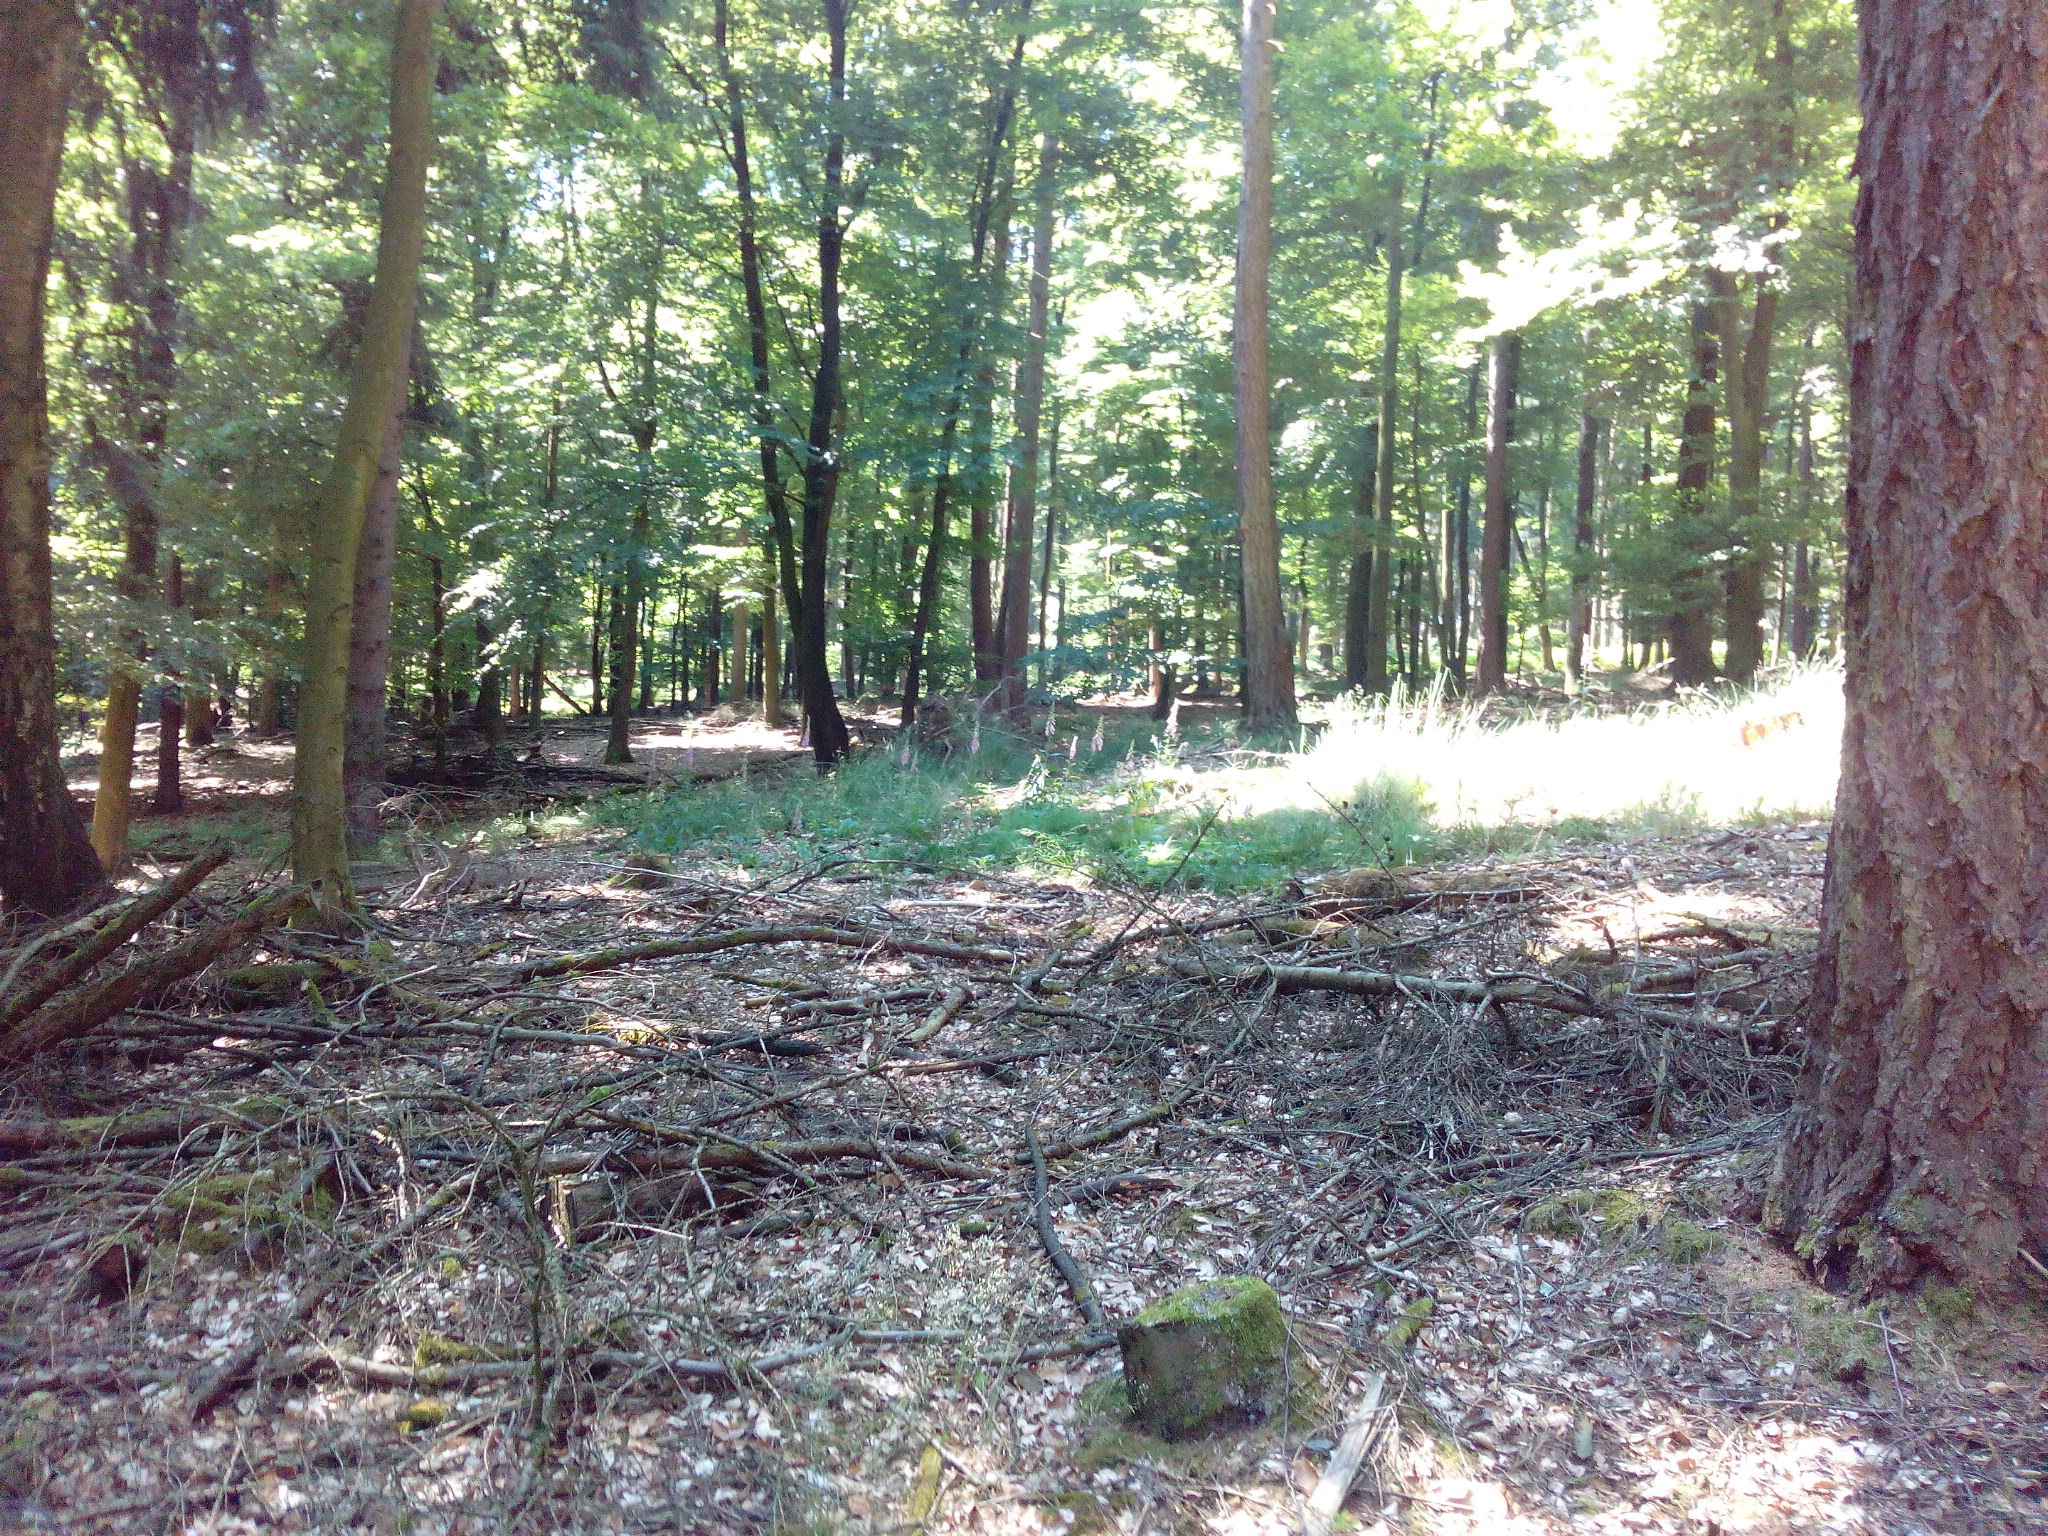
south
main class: Woodland
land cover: Spruce dominated coniferous woodland
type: hemiboreal forest and nemoral coniferous forest and mixed broadleaved-coniferous forest
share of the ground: > 75 %
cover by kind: coniferous forest trees 75 %, herbaceous plants 20 %, shrubs 5 %
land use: Forestry
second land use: Amenities, museums, leisure
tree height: > 5 m
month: July
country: DE
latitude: 52.2330
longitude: 9.6048
